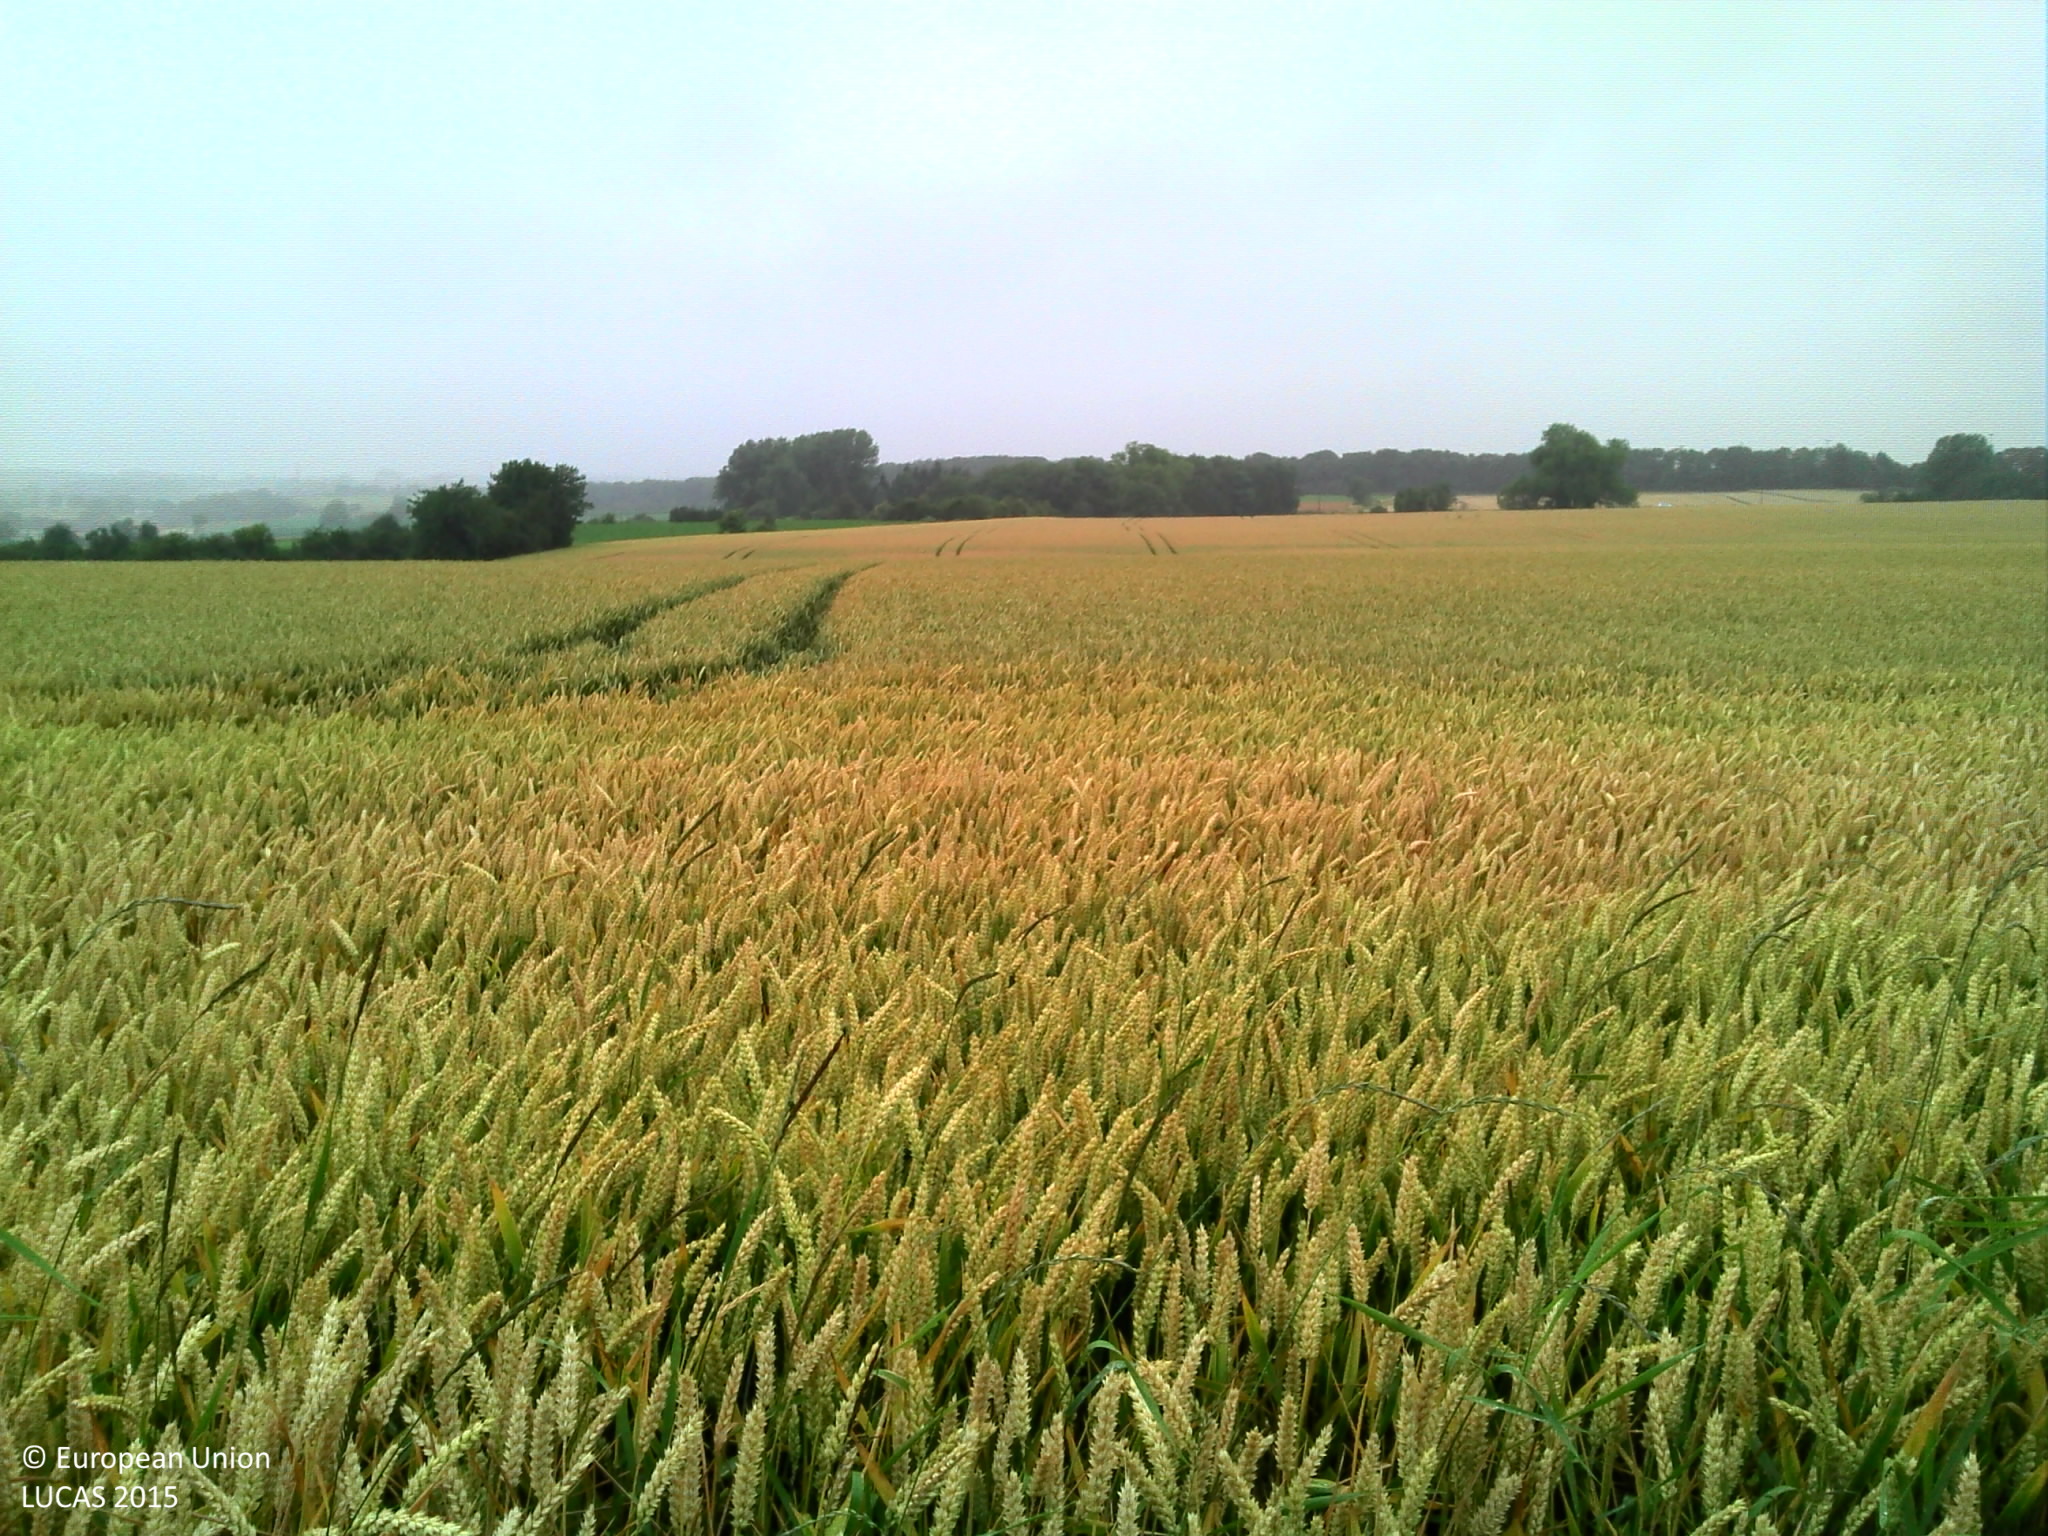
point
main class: Cropland
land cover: Common wheat
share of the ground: > 75 %
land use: Agriculture (excluding fallow land and kitchen gardens)
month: July
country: BE
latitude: 50.4817
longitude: 4.0896
